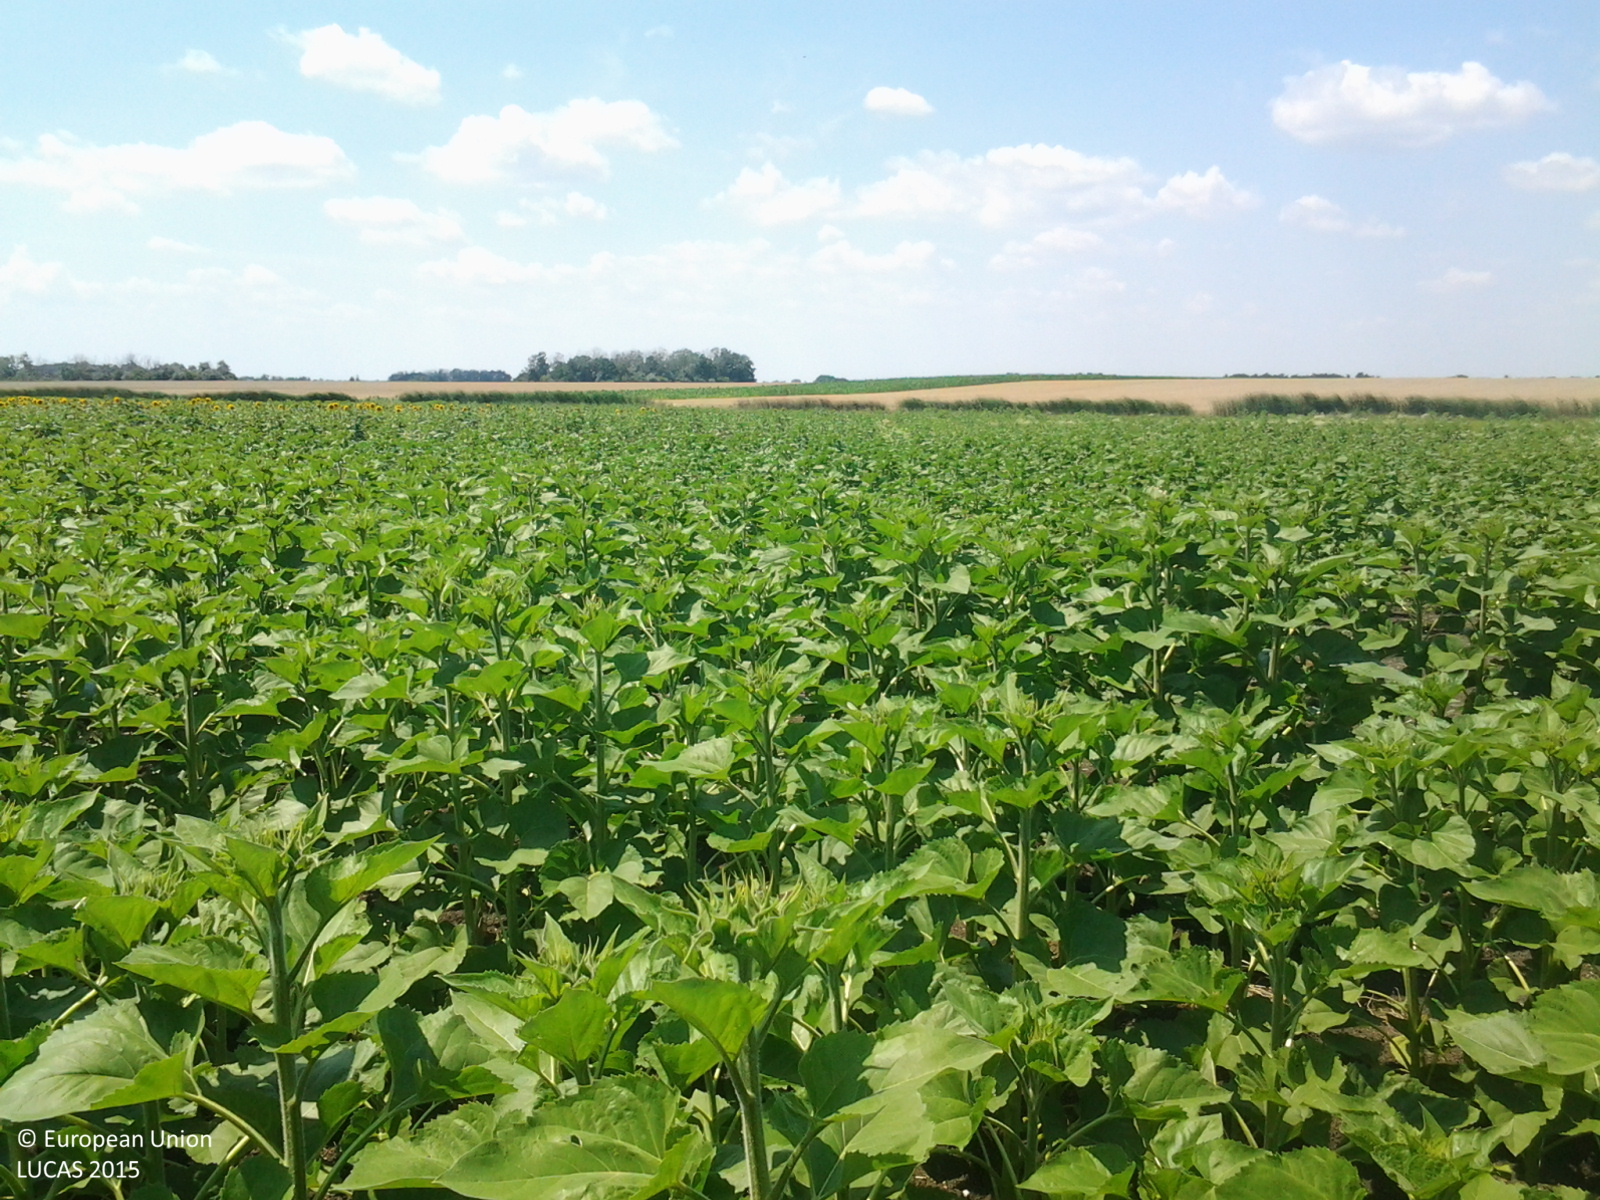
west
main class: Cropland
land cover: Sunflower
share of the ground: > 75 %
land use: Agriculture (excluding fallow land and kitchen gardens)
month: July
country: HU
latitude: 46.9481
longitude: 20.4203
